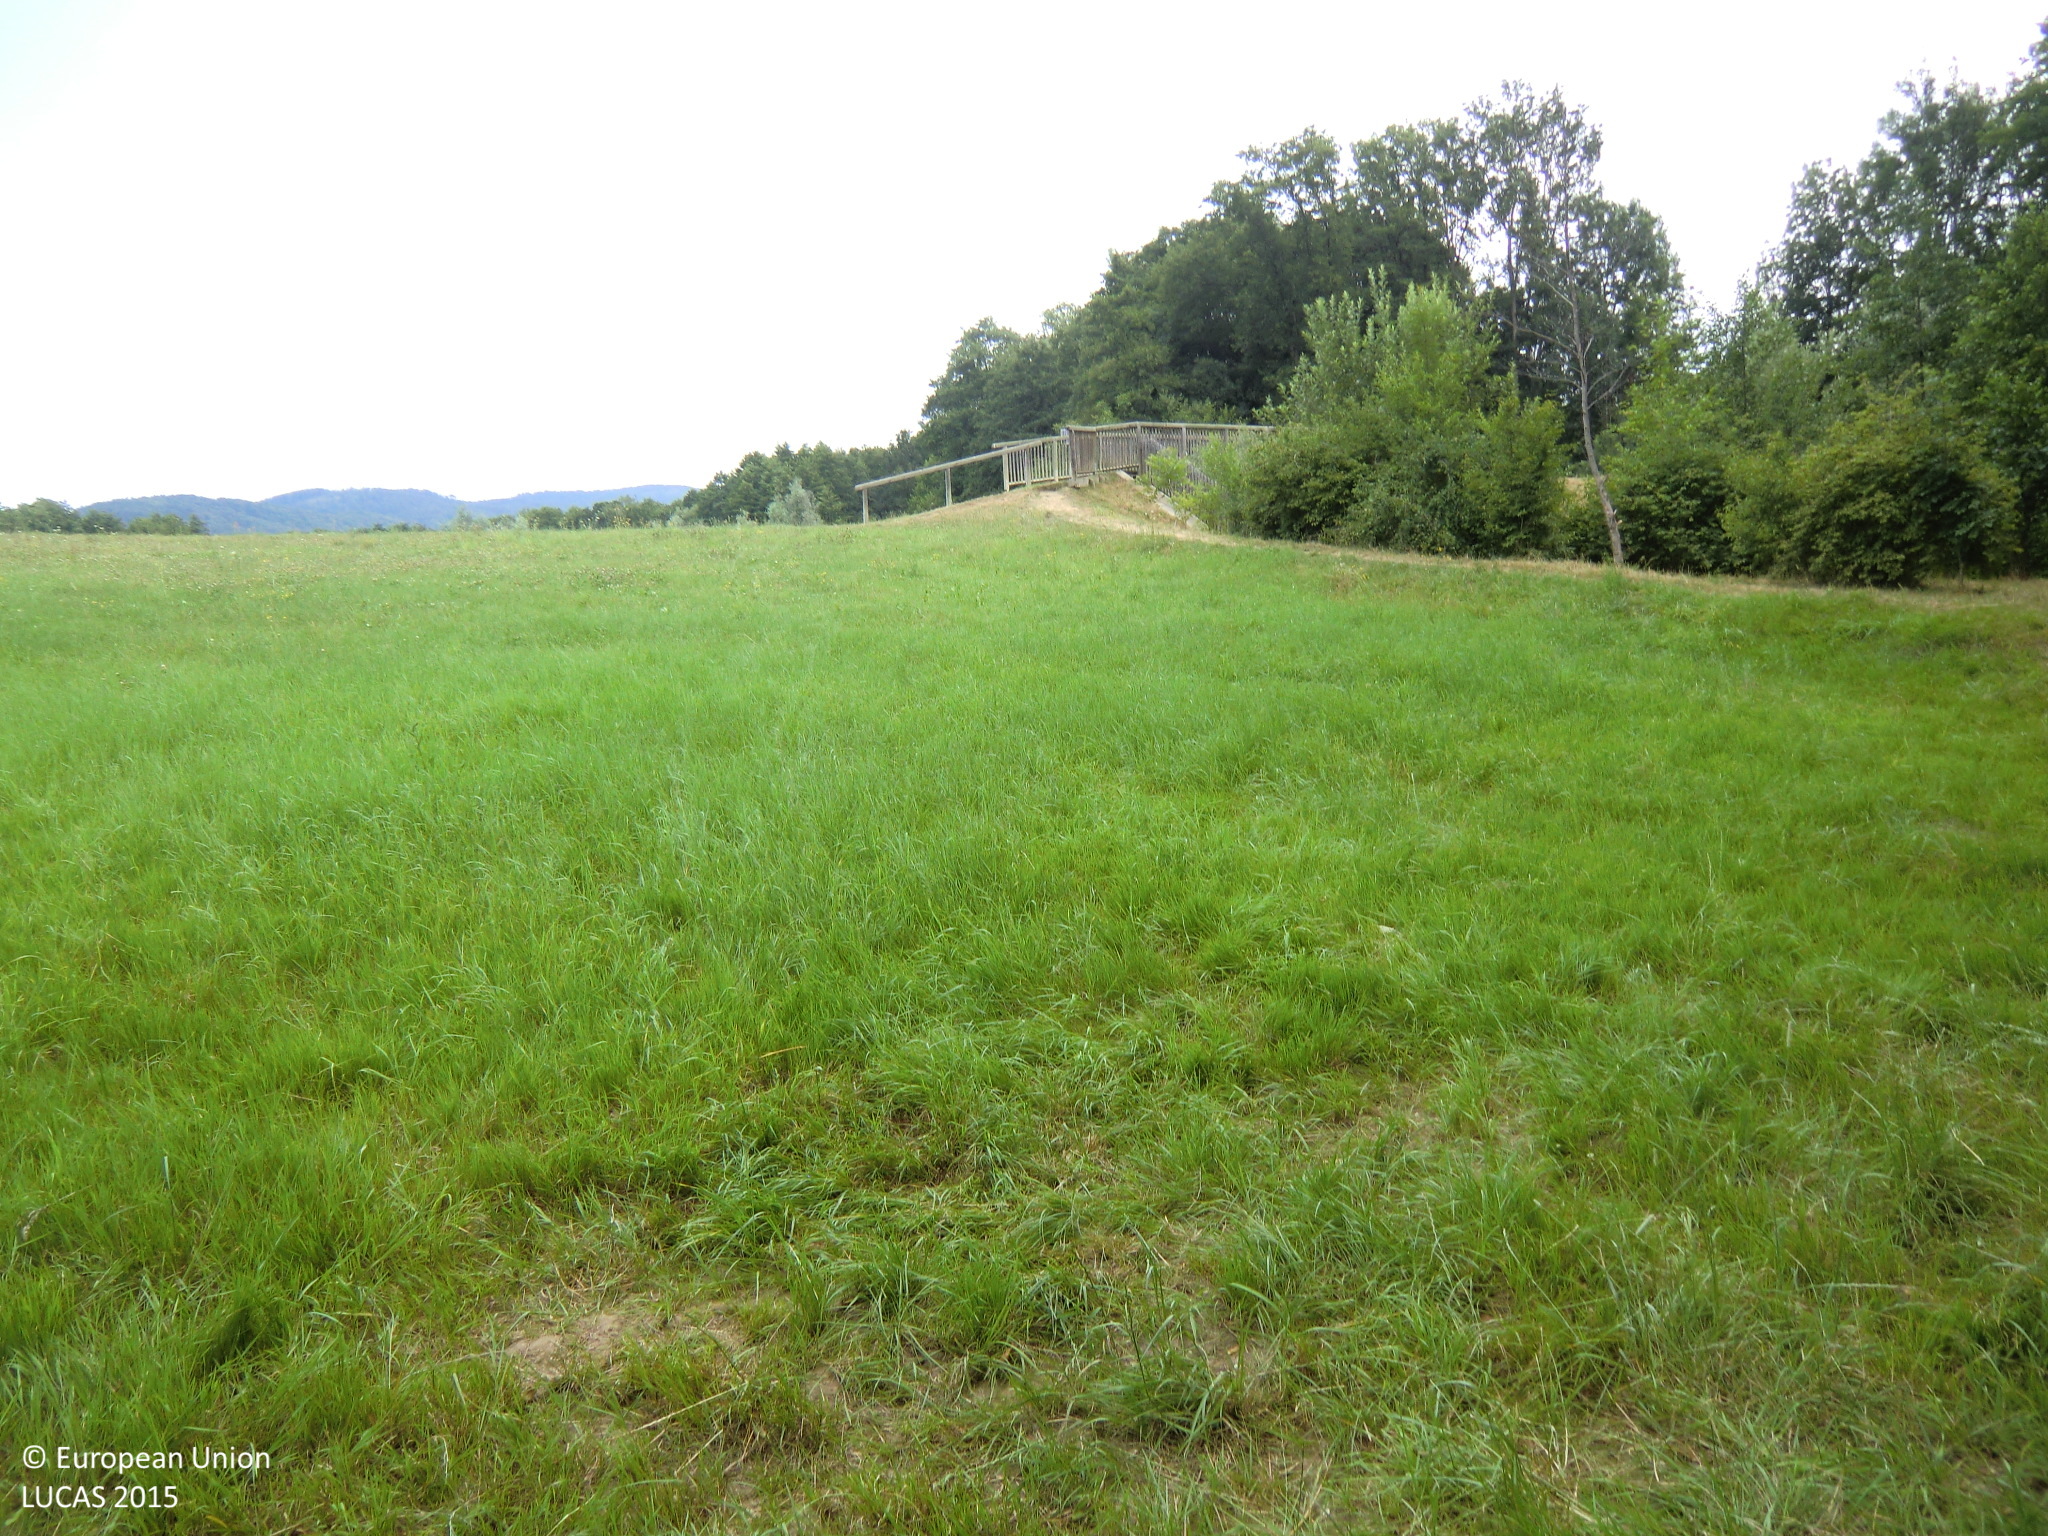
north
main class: Grassland
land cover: Grassland with sparse tree/shrub cover
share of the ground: > 75 %
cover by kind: herbaceous plants 95 %, broadleaved forest trees 5 %
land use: Agriculture (excluding fallow land and kitchen gardens)
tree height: < 5 m
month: July
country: AT
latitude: 47.1163
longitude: 15.4168
